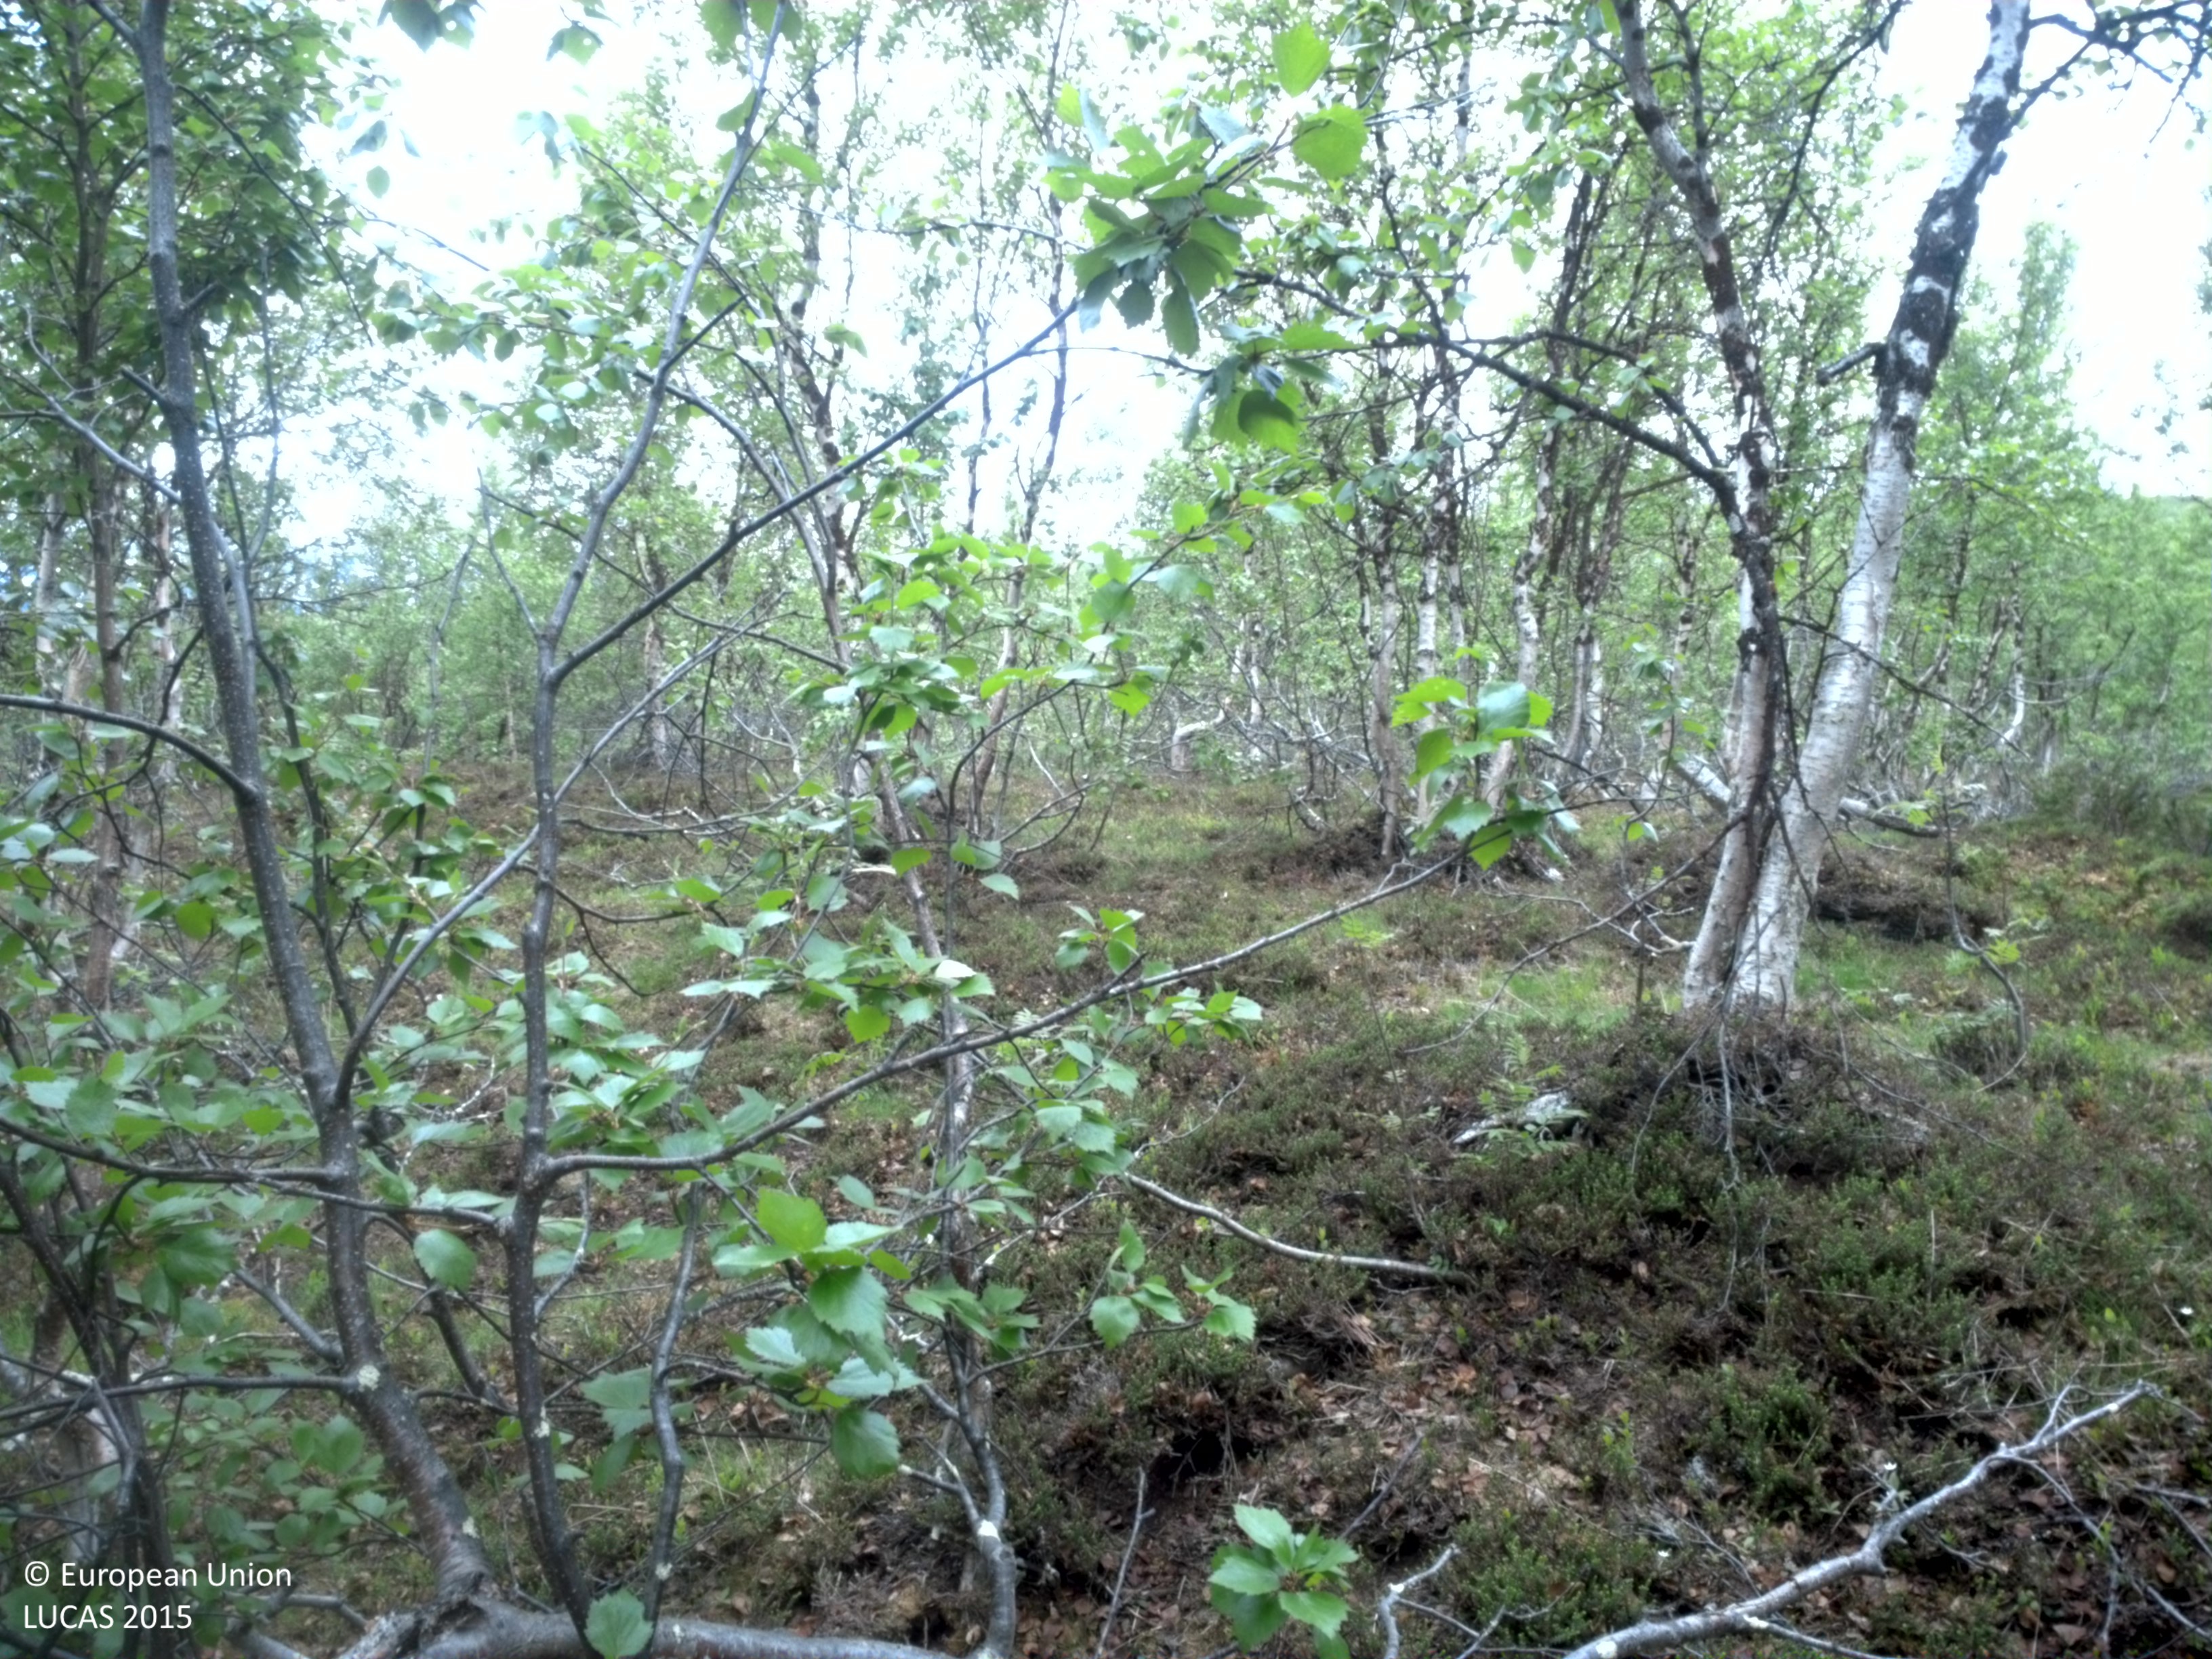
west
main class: Woodland
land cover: Broadleaved woodland
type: non-riverine alder, birch or aspen forest
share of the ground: 50 - 75 %
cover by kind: broadleaved forest trees 60 %, shrubs 35 %, lichens and mosses 5 %
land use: Amenities, museums, leisure
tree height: < 5 m
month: July
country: SE
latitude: 67.7305
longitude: 17.4843
